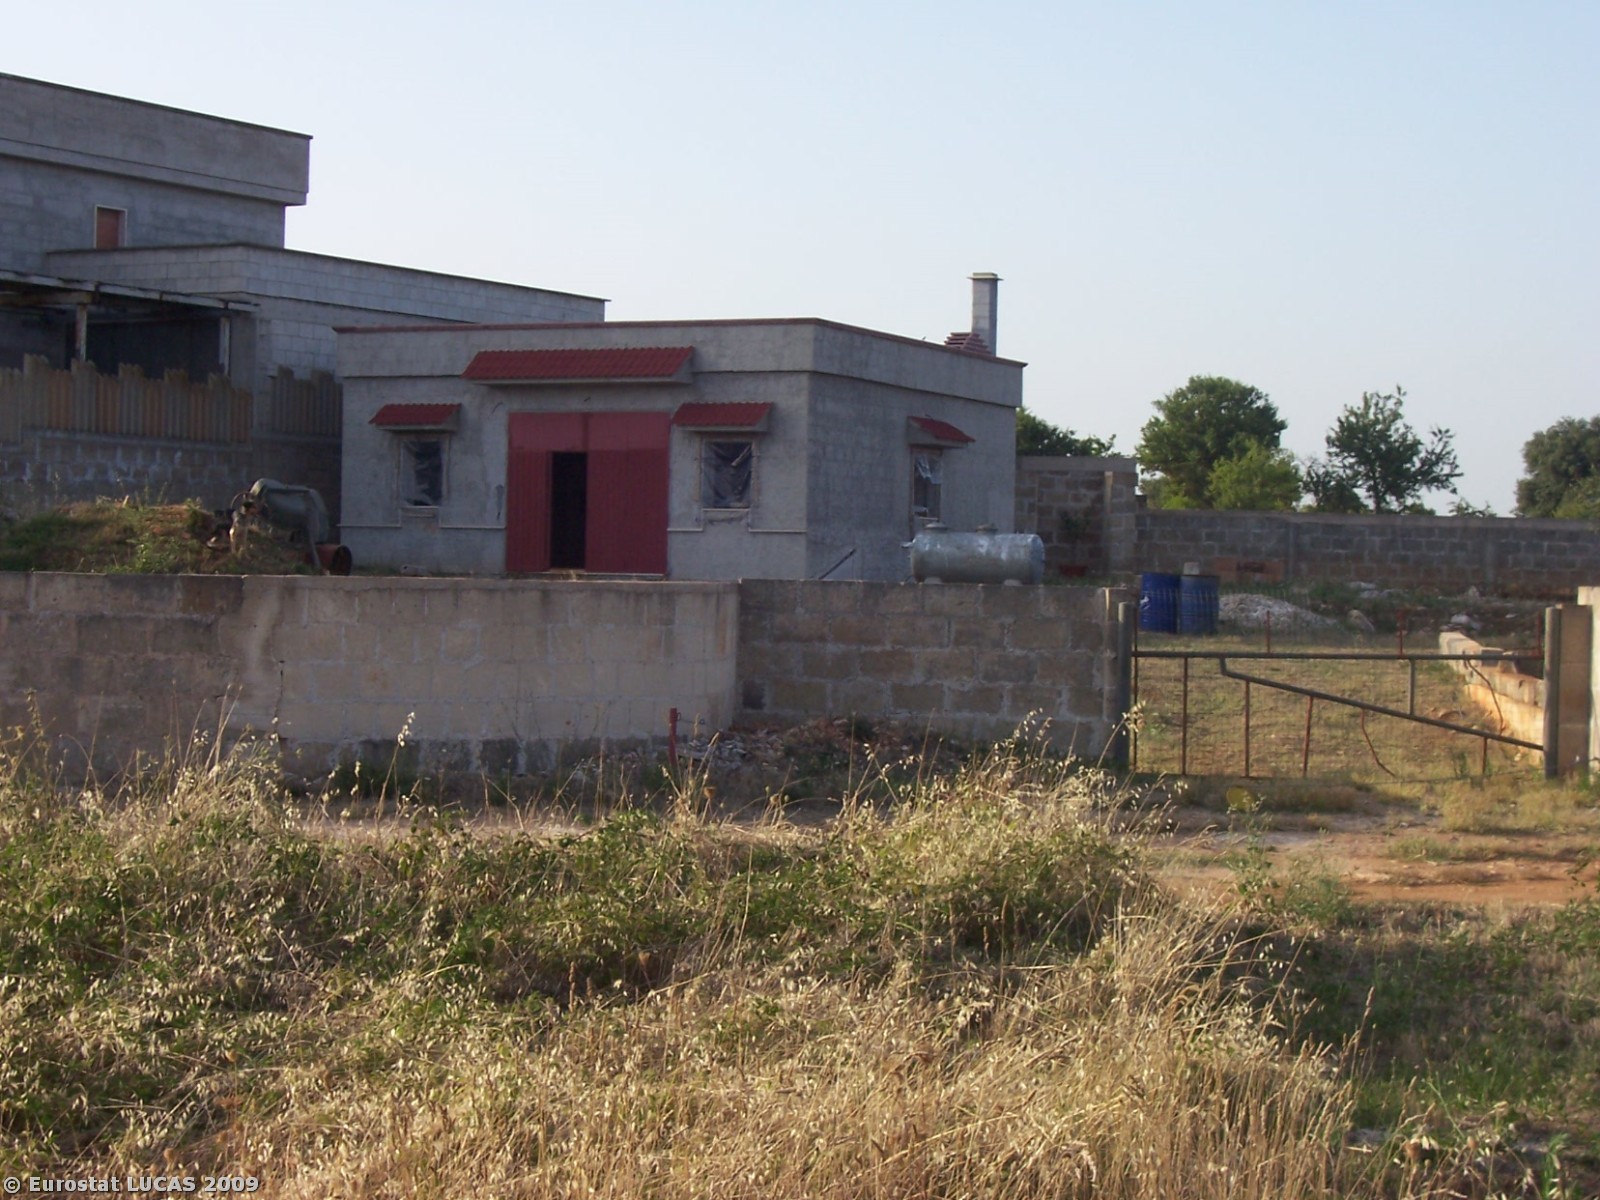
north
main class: Grassland
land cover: Spontaneously vegetated surfaces
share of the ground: > 75 %
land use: Fallow land
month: July
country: IT
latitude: 40.6494
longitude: 17.5336
